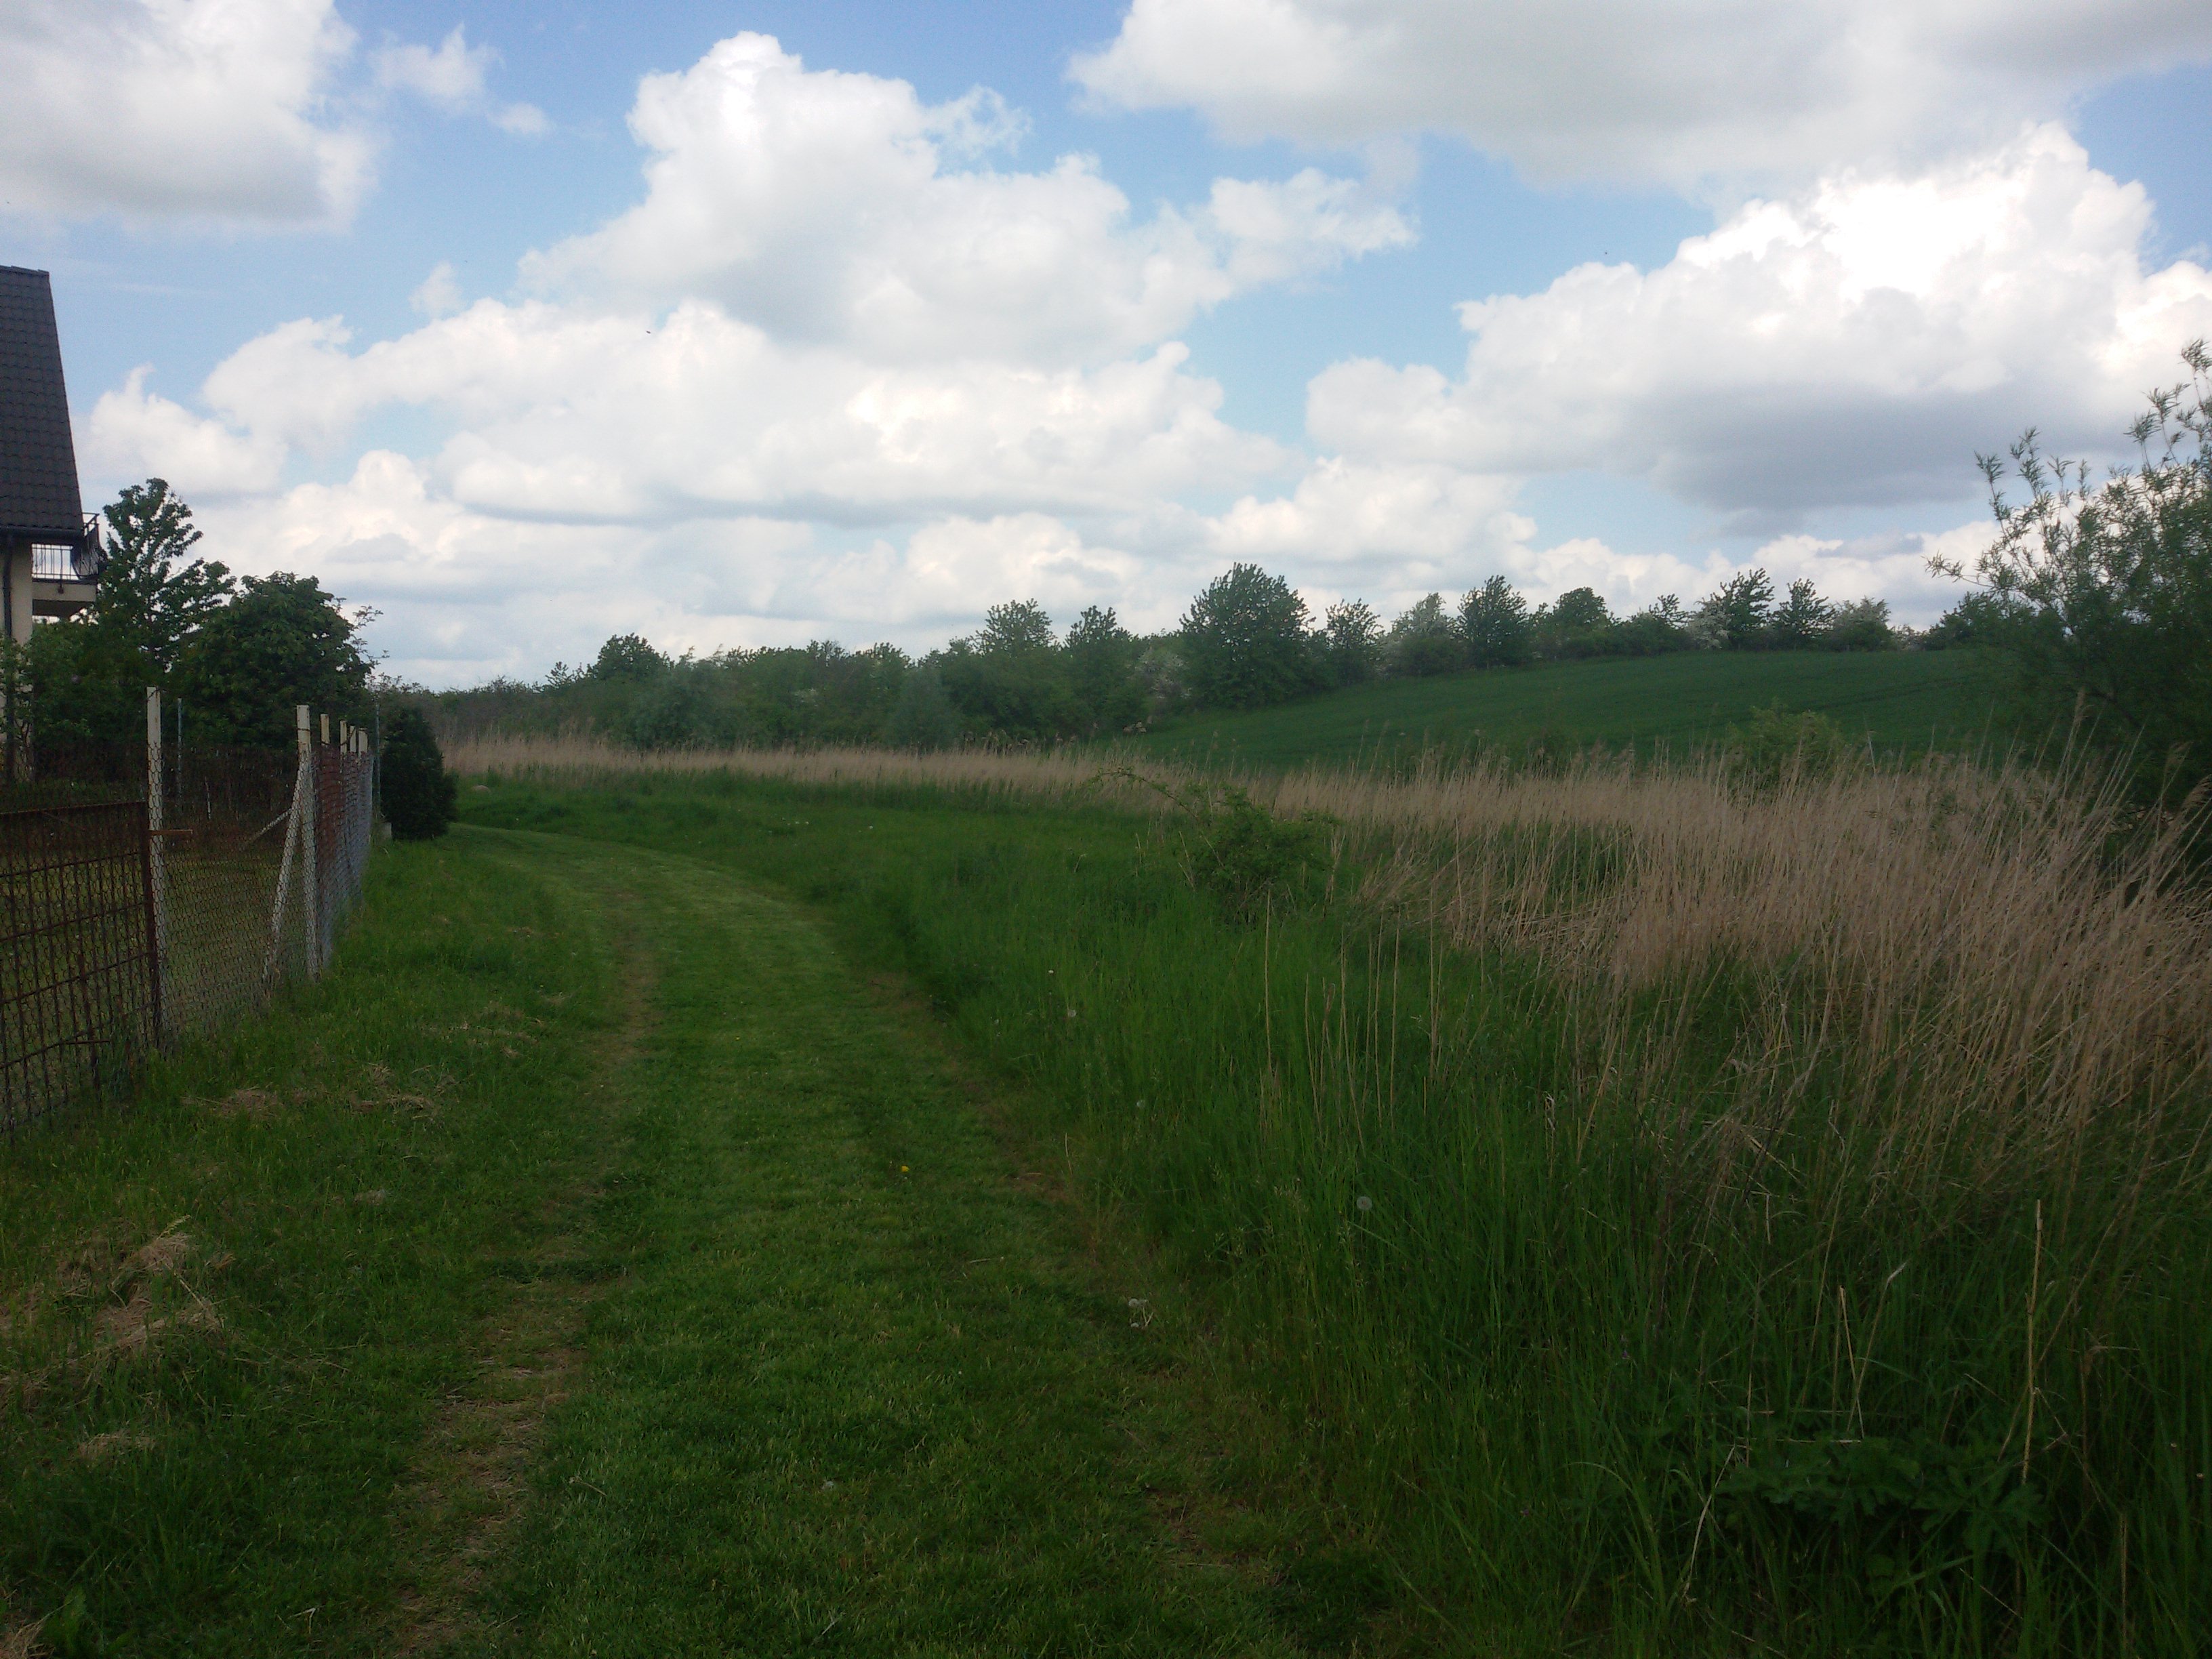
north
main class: Cropland
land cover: Cherry fruit
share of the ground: 50 - 75 %
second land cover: Grassland without tree/shrub cover
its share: > 75 %
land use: Kitchen garden
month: May
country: PL
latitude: 53.3546
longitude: 14.4933
